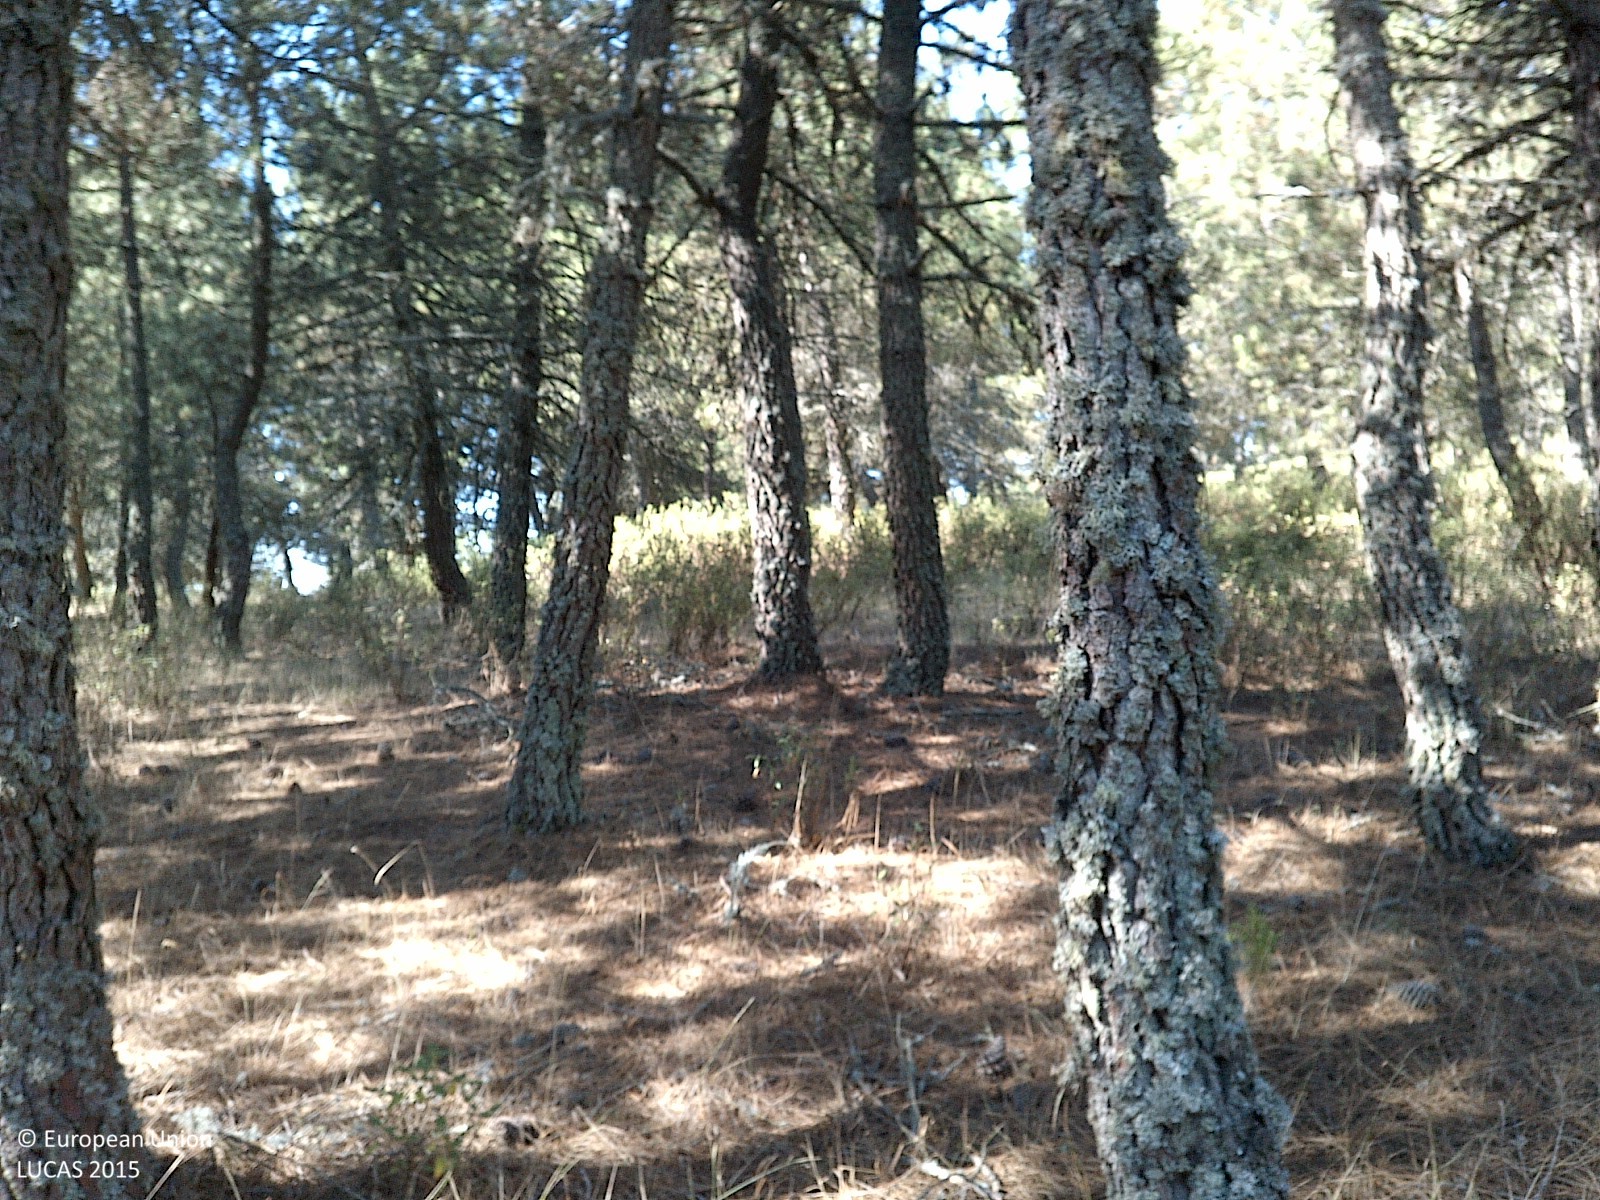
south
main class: Woodland
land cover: Pine dominated coniferous woodland
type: coniferous forest of the mediterranean region
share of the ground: > 75 %
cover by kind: coniferous forest trees 85 %, shrubs 10 %, lichens and mosses 5 %
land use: Forestry
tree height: > 5 m
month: July
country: ES
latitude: 41.7746
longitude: -3.1476
